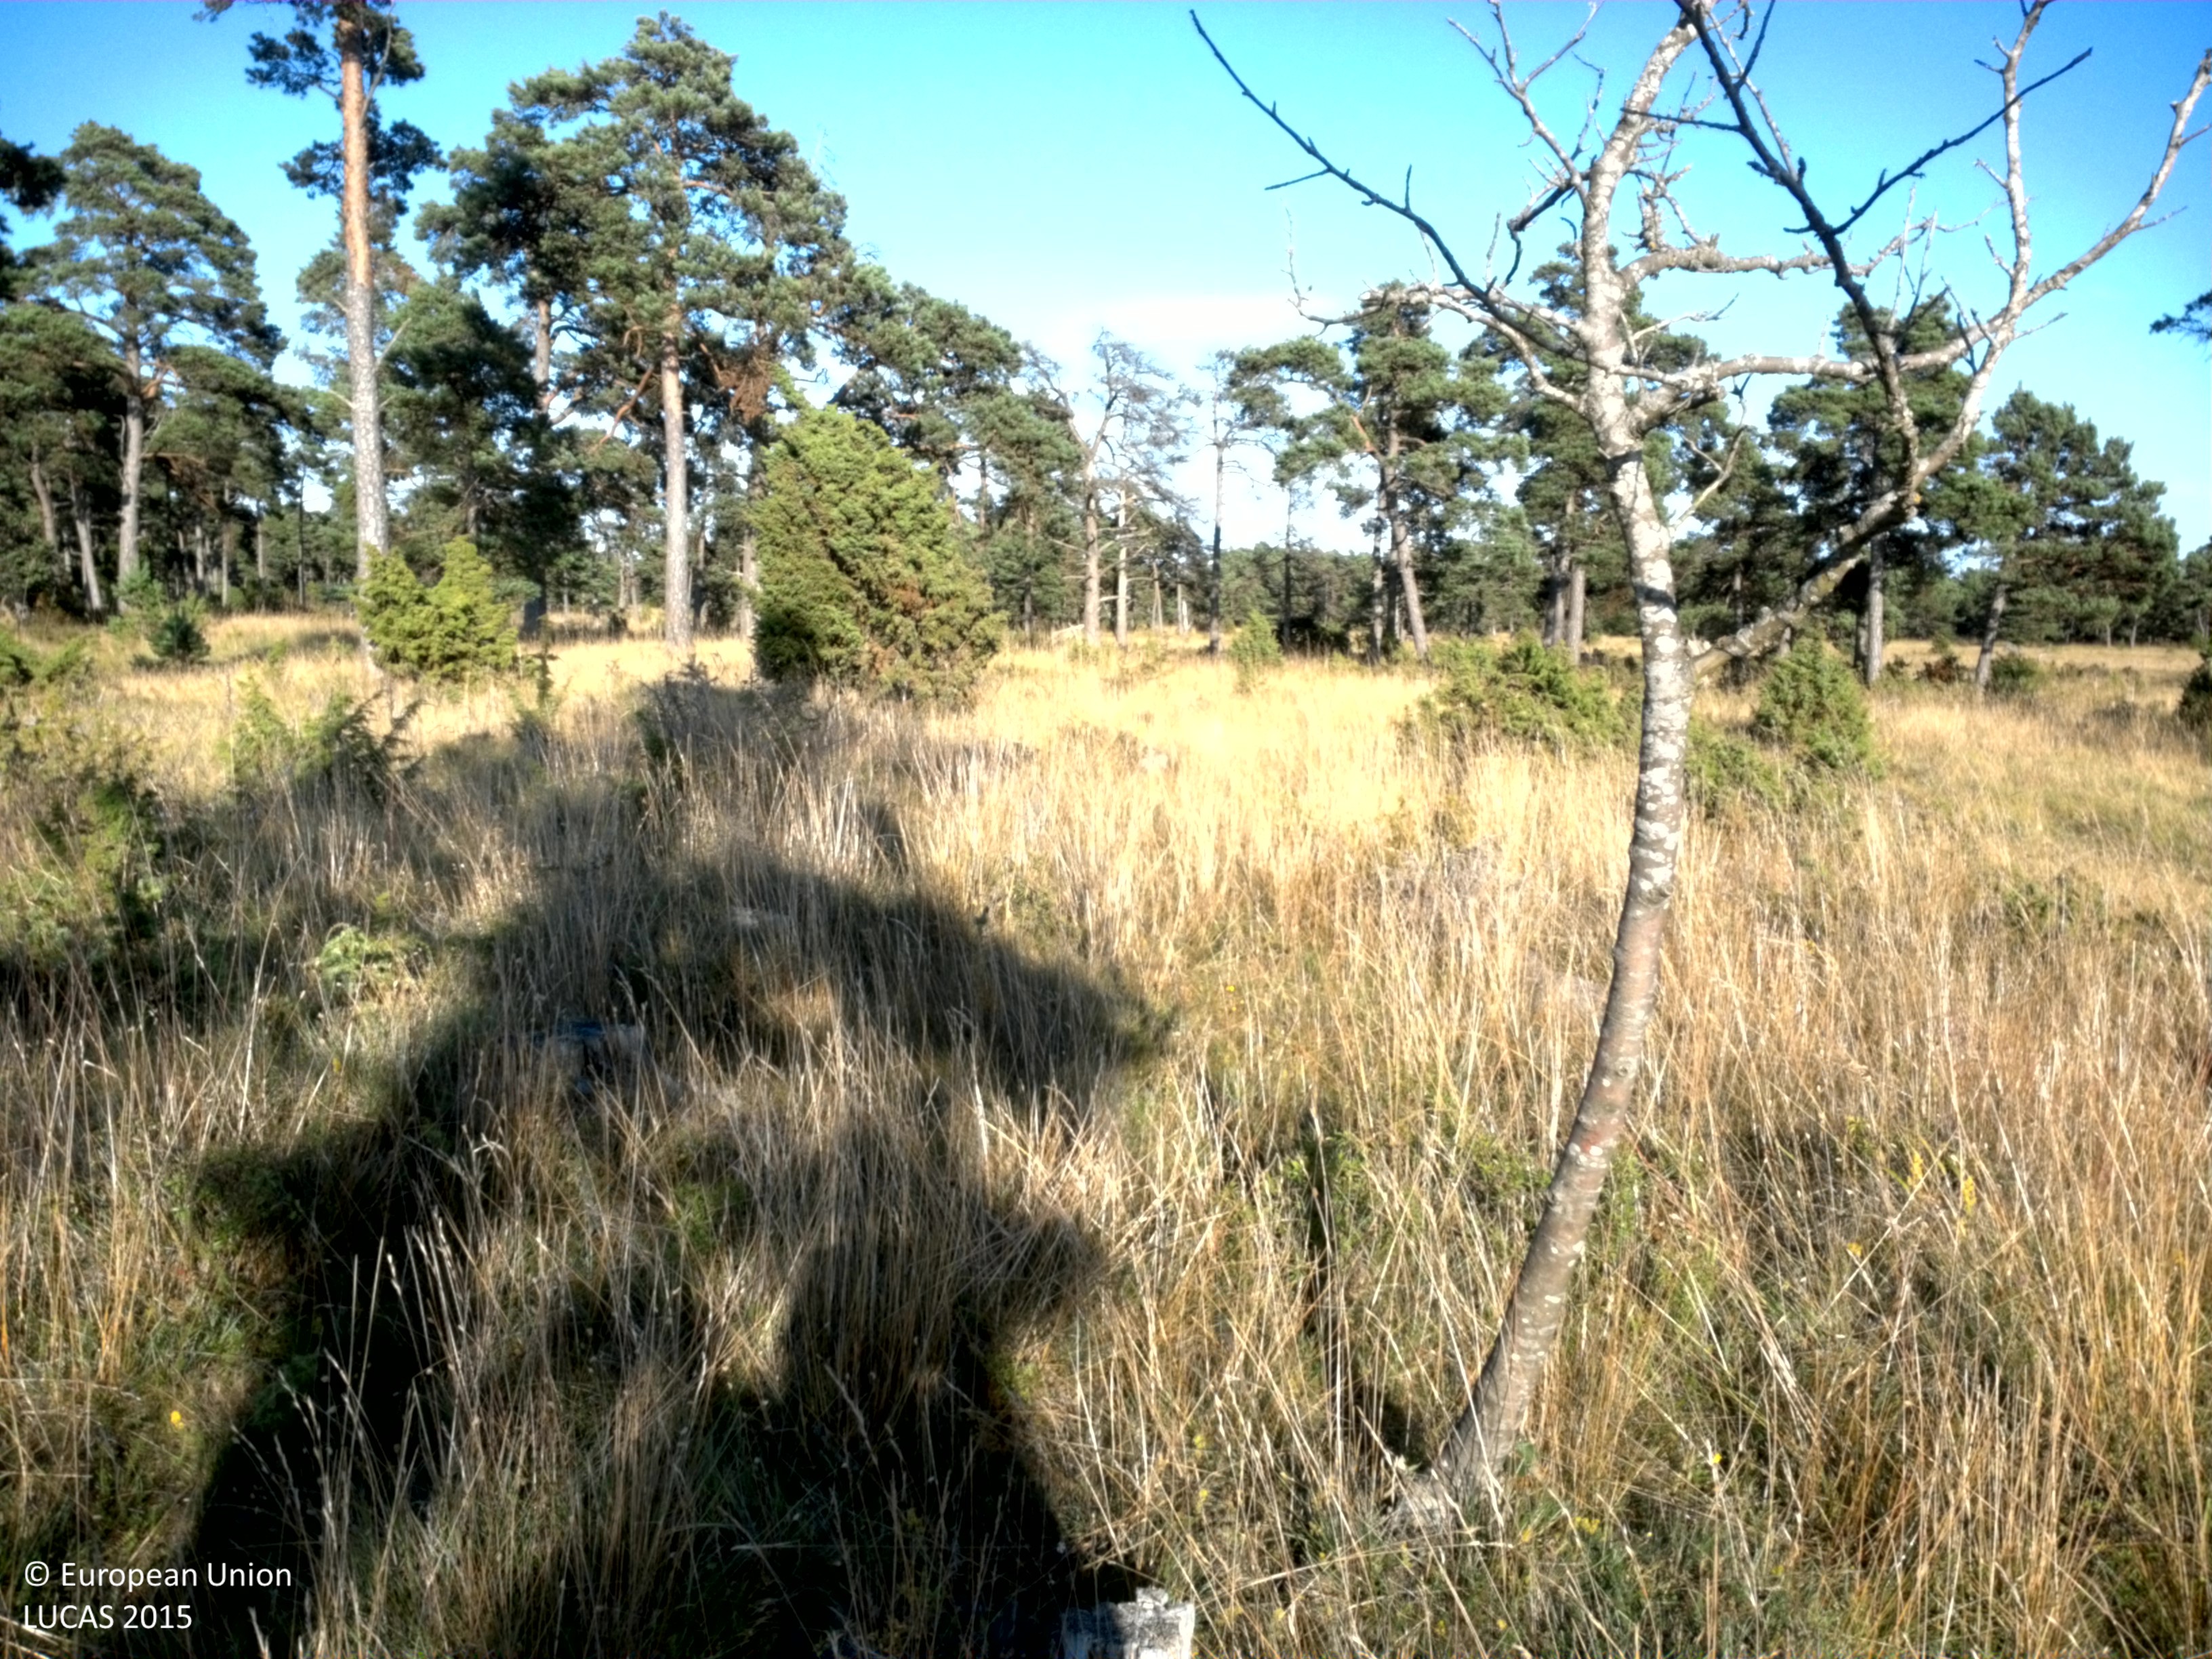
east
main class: Grassland
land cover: Grassland with sparse tree/shrub cover
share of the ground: > 75 %
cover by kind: herbaceous plants 90 %, coniferous forest trees 5 %, shrubs 5 %
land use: Agriculture (excluding fallow land and kitchen gardens)
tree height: > 5 m
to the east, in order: Grassland with sparse tree/shrub cover; Pine dominated coniferous woodland; Grassland without tree/shrub cover
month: July
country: SE
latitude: 57.1586
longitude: 18.4247
